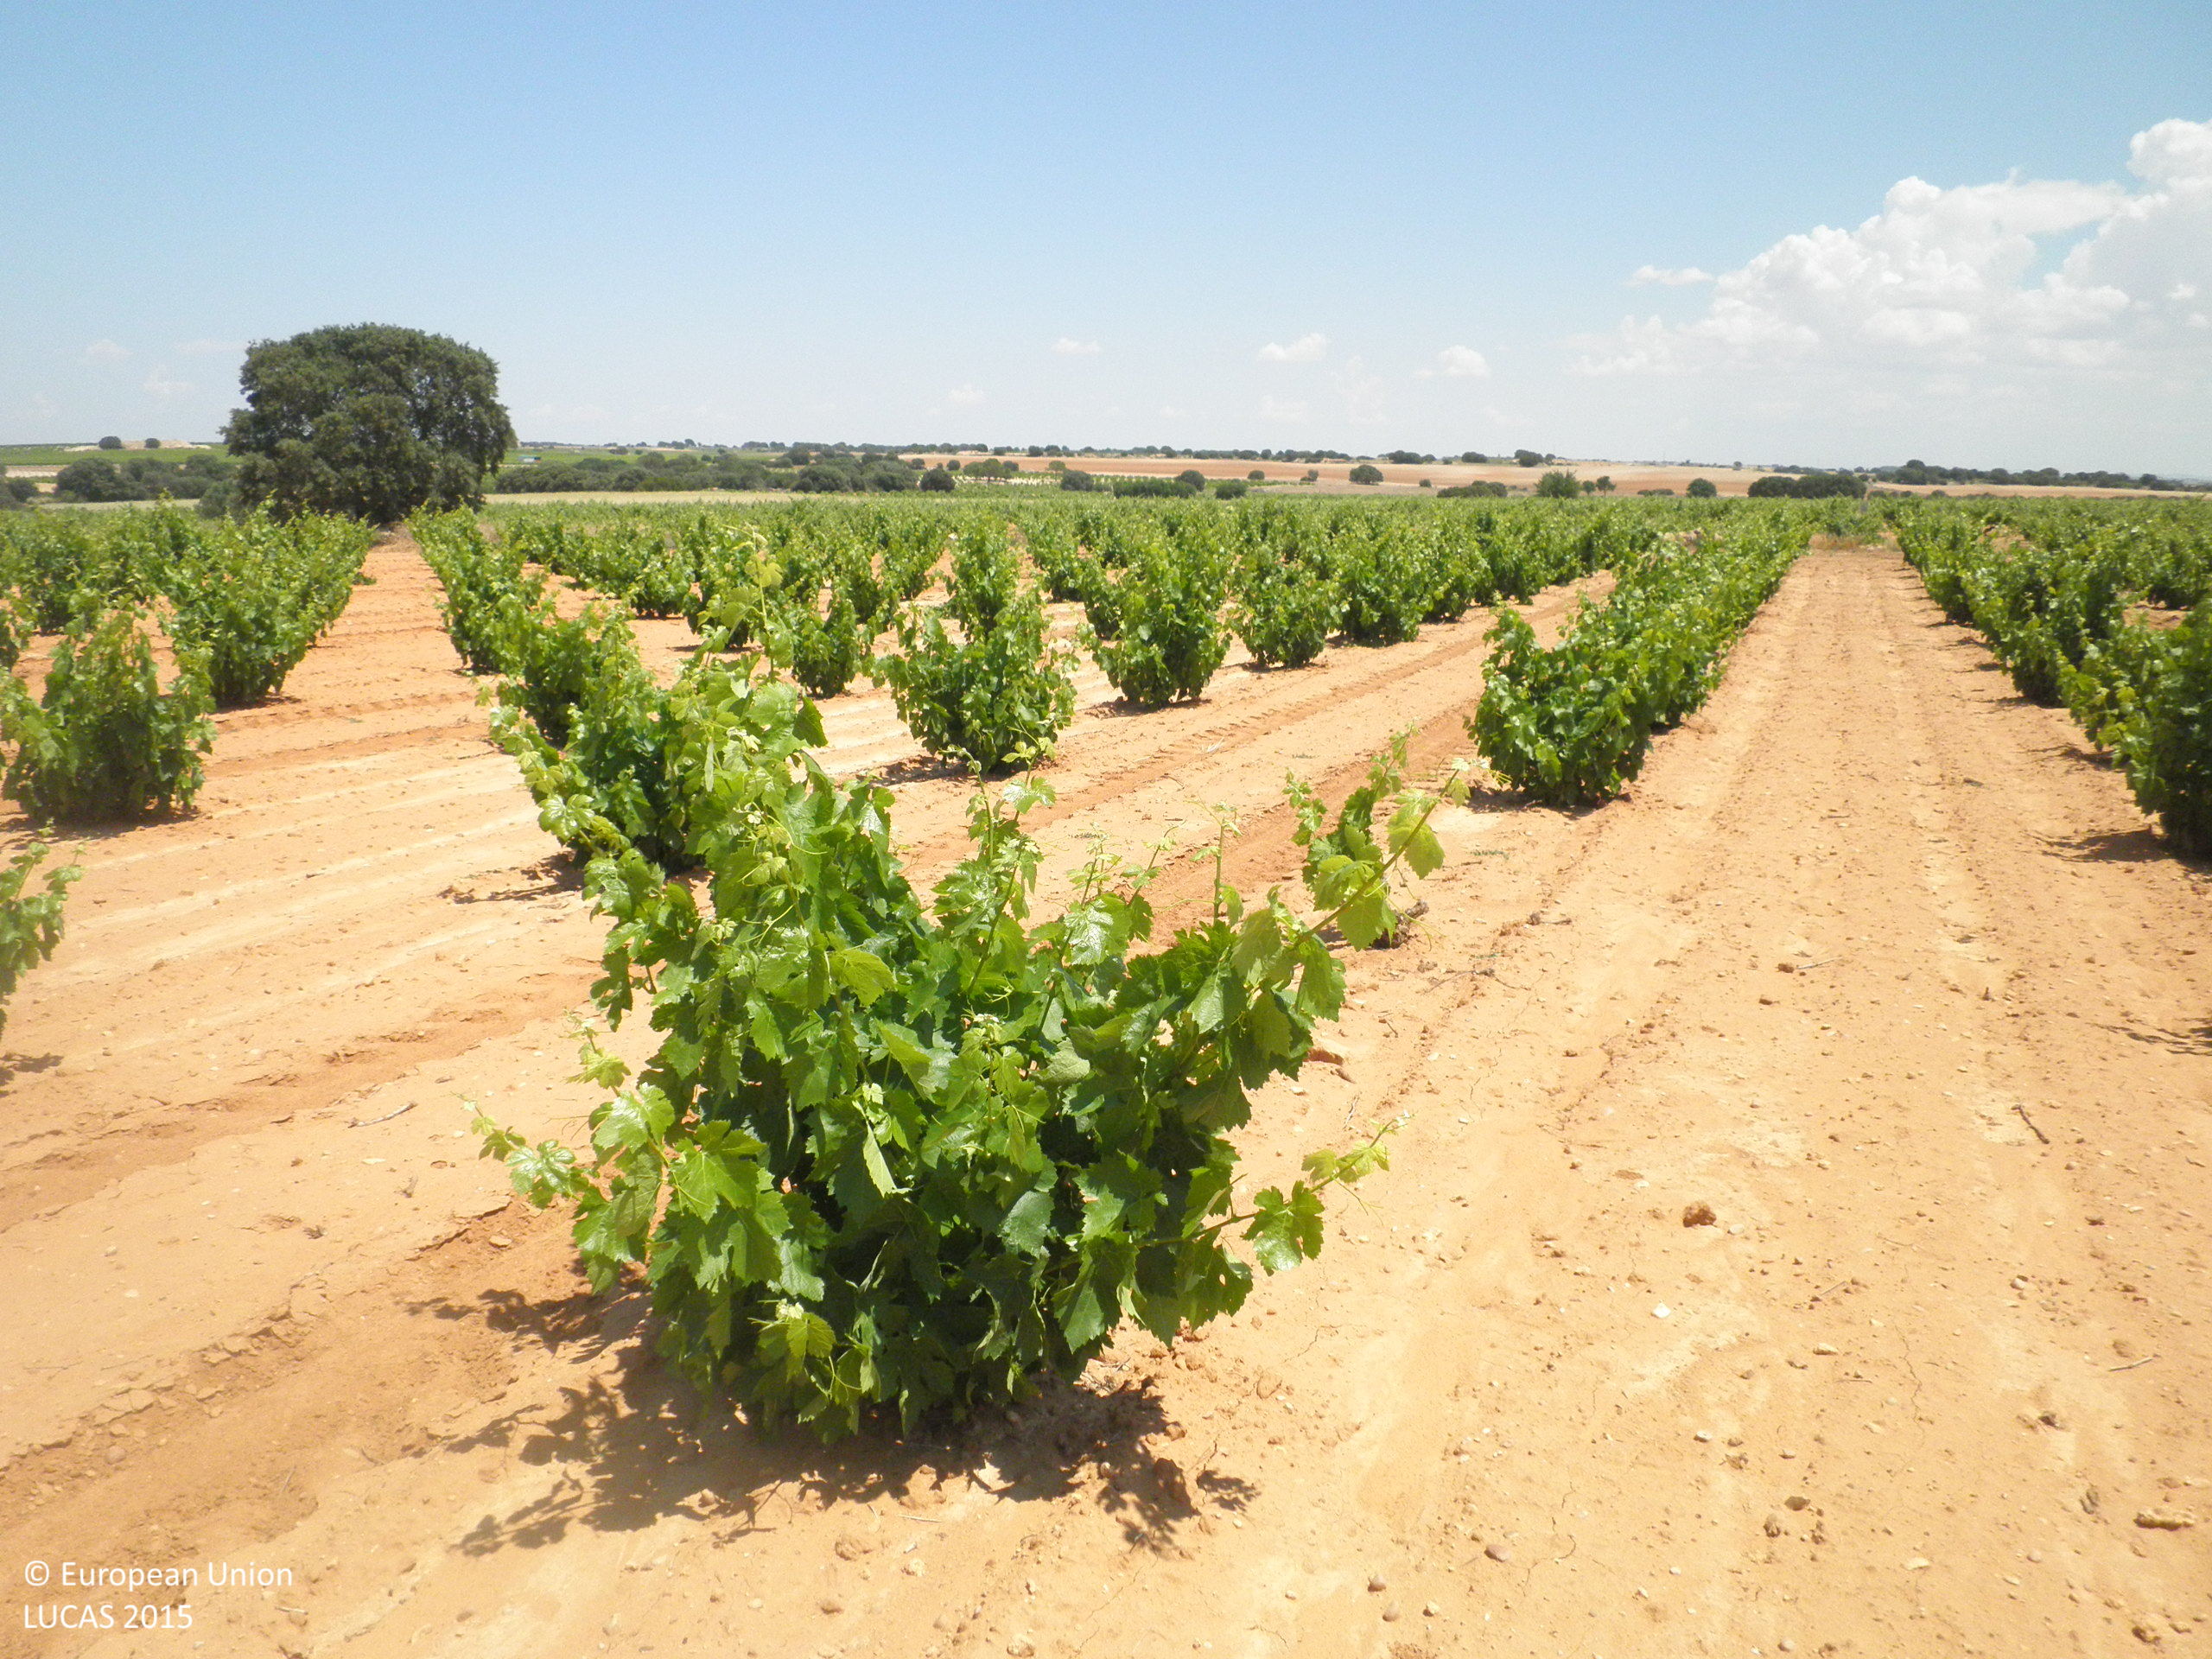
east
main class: Cropland
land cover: Vineyards
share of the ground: < 10 %
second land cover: Other bare soil
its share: > 75 %
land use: Agriculture (excluding fallow land and kitchen gardens)
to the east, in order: Vineyards; Other bare soil; Grass margins; Vineyards; Durum wheat; Grass margins; Vineyards
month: June
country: ES
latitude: 39.2822
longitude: -1.7701
